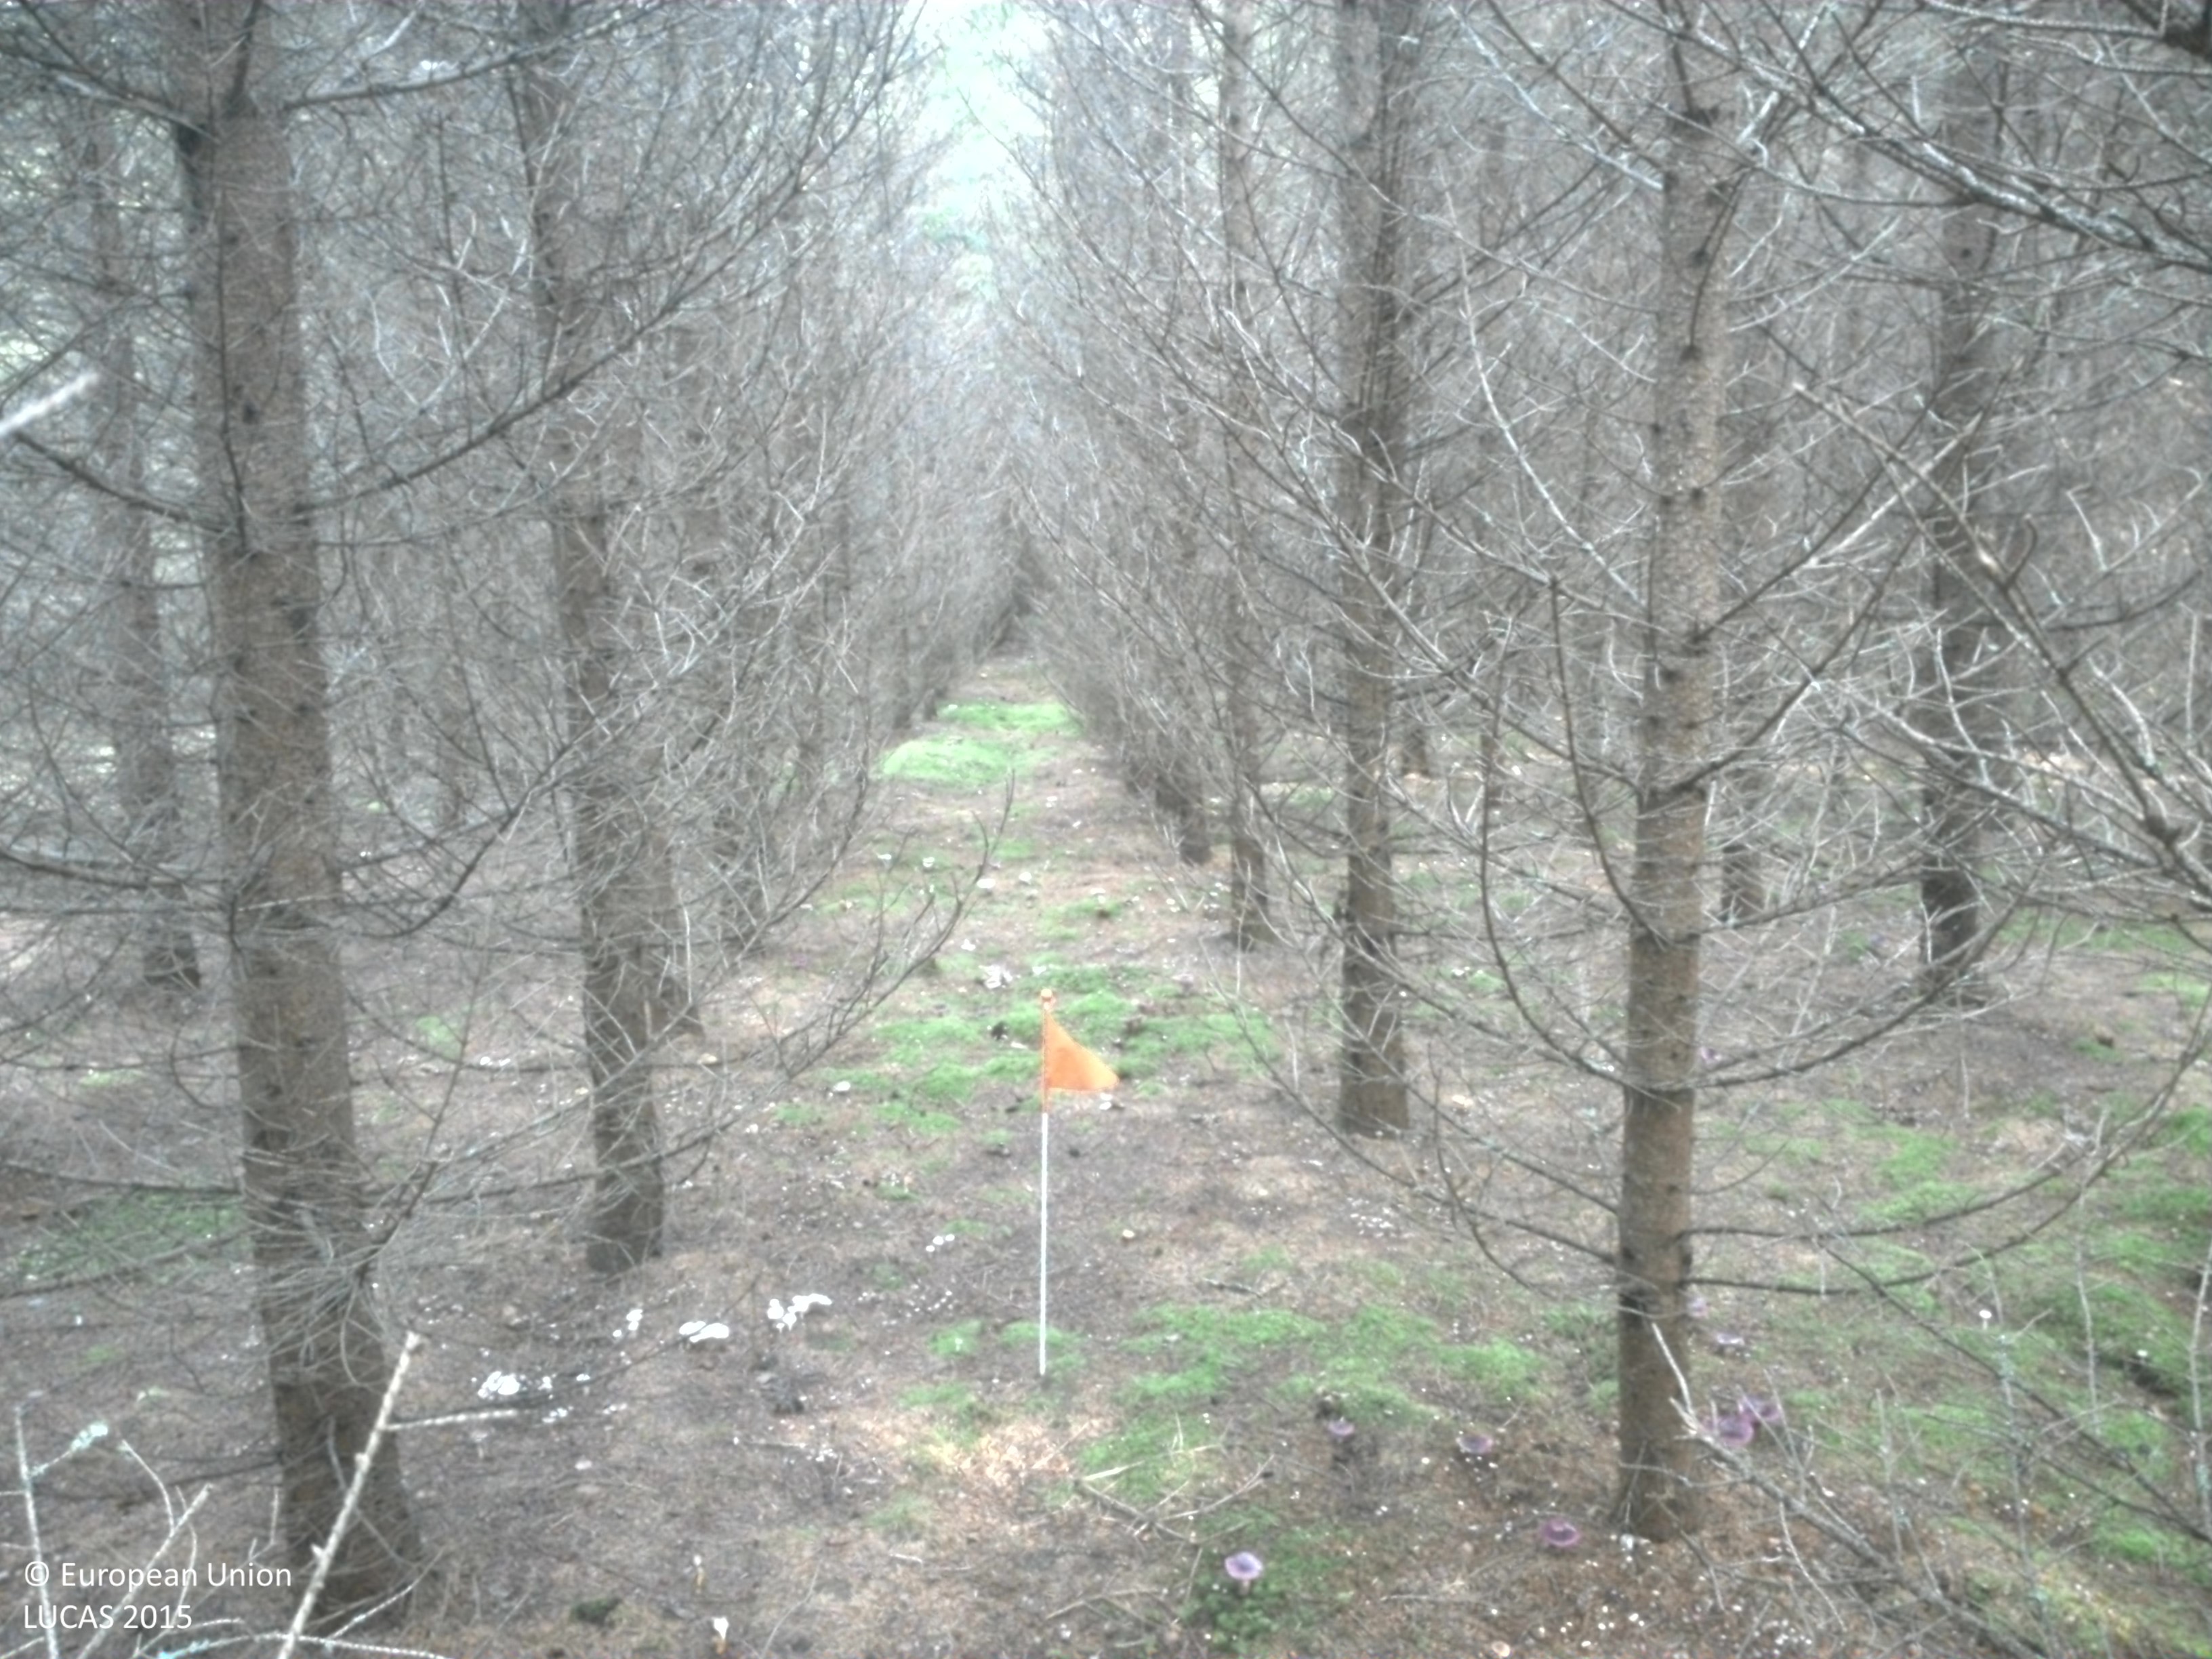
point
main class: Woodland
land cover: Spruce dominated coniferous woodland
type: boreal forest
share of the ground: > 75 %
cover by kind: coniferous forest trees 85 %, lichens and mosses 15 %
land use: Forestry
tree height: > 5 m
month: September
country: SE
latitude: 59.4800
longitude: 15.4462
